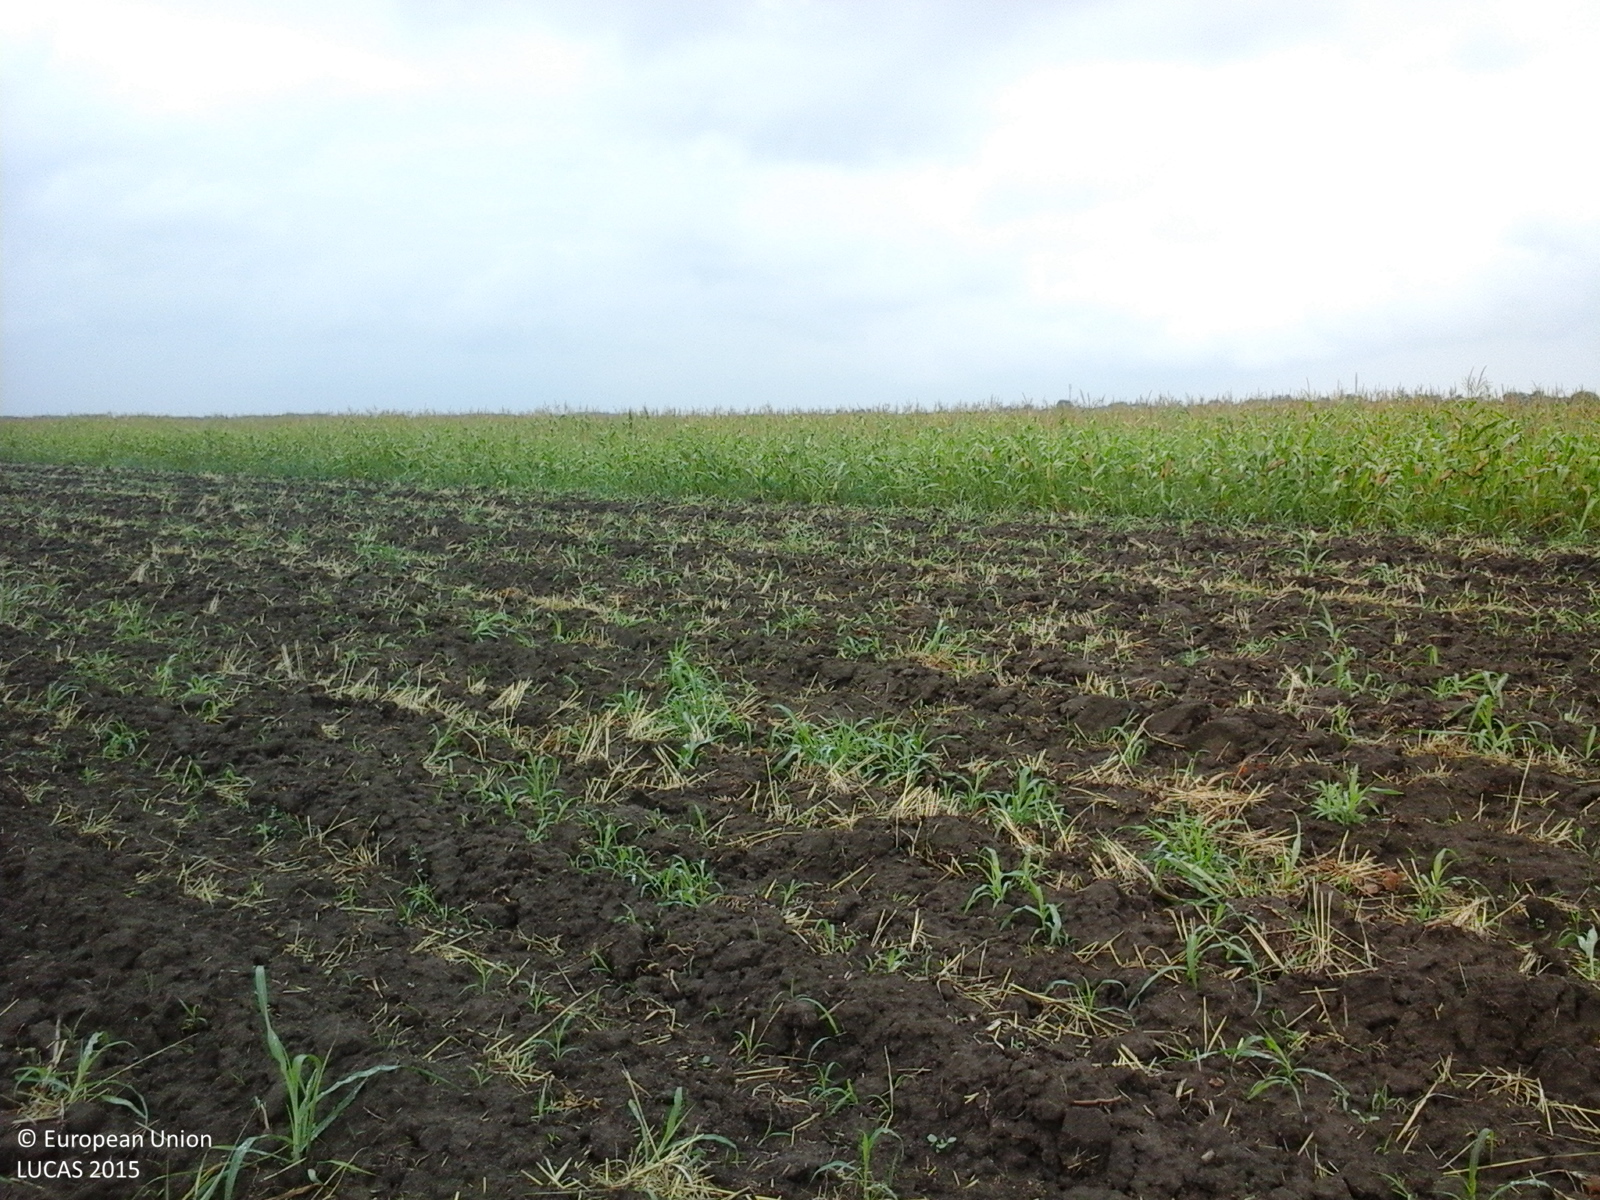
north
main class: Cropland
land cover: Common wheat
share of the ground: < 10 %
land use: Agriculture (excluding fallow land and kitchen gardens)
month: August
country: RO
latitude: 46.0375
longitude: 20.4512
